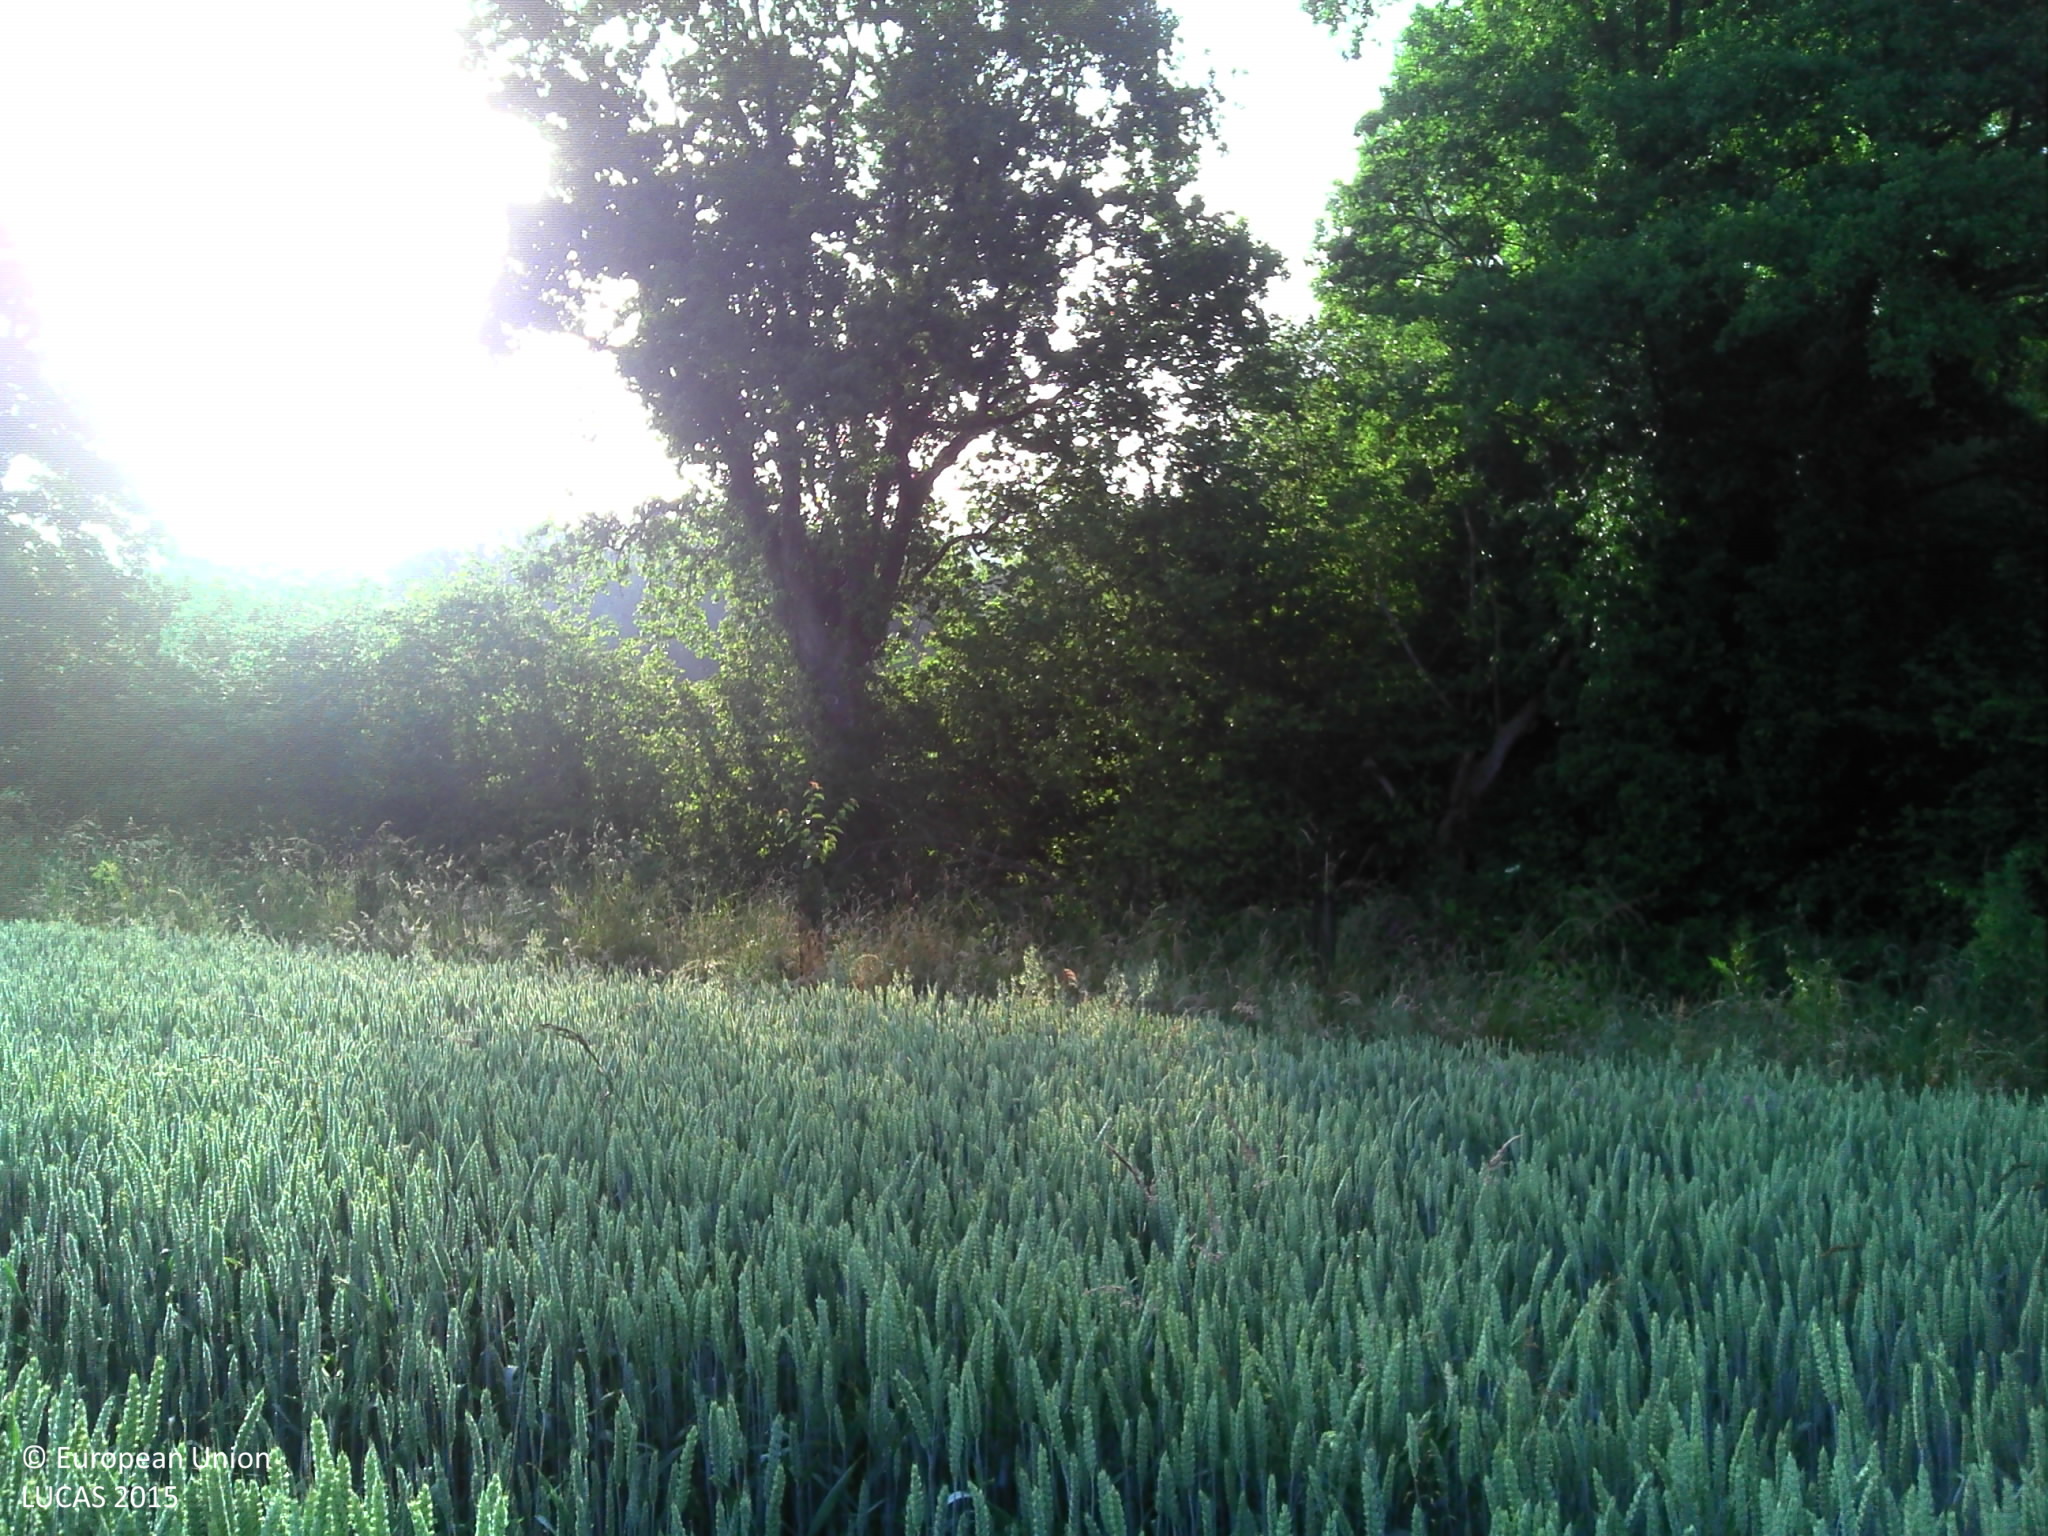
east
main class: Cropland
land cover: Common wheat
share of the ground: > 75 %
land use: Agriculture (excluding fallow land and kitchen gardens)
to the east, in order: Common wheat; Grassland without tree/shrub cover; Broadleaved woodland; Inland fresh water bodies; Broadleaved woodland; Grassland without tree/shrub cover; Fences; Abandoned hedges; Grassland without tree/shrub cover
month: June
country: FR
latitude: 48.2441
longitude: -1.7789
